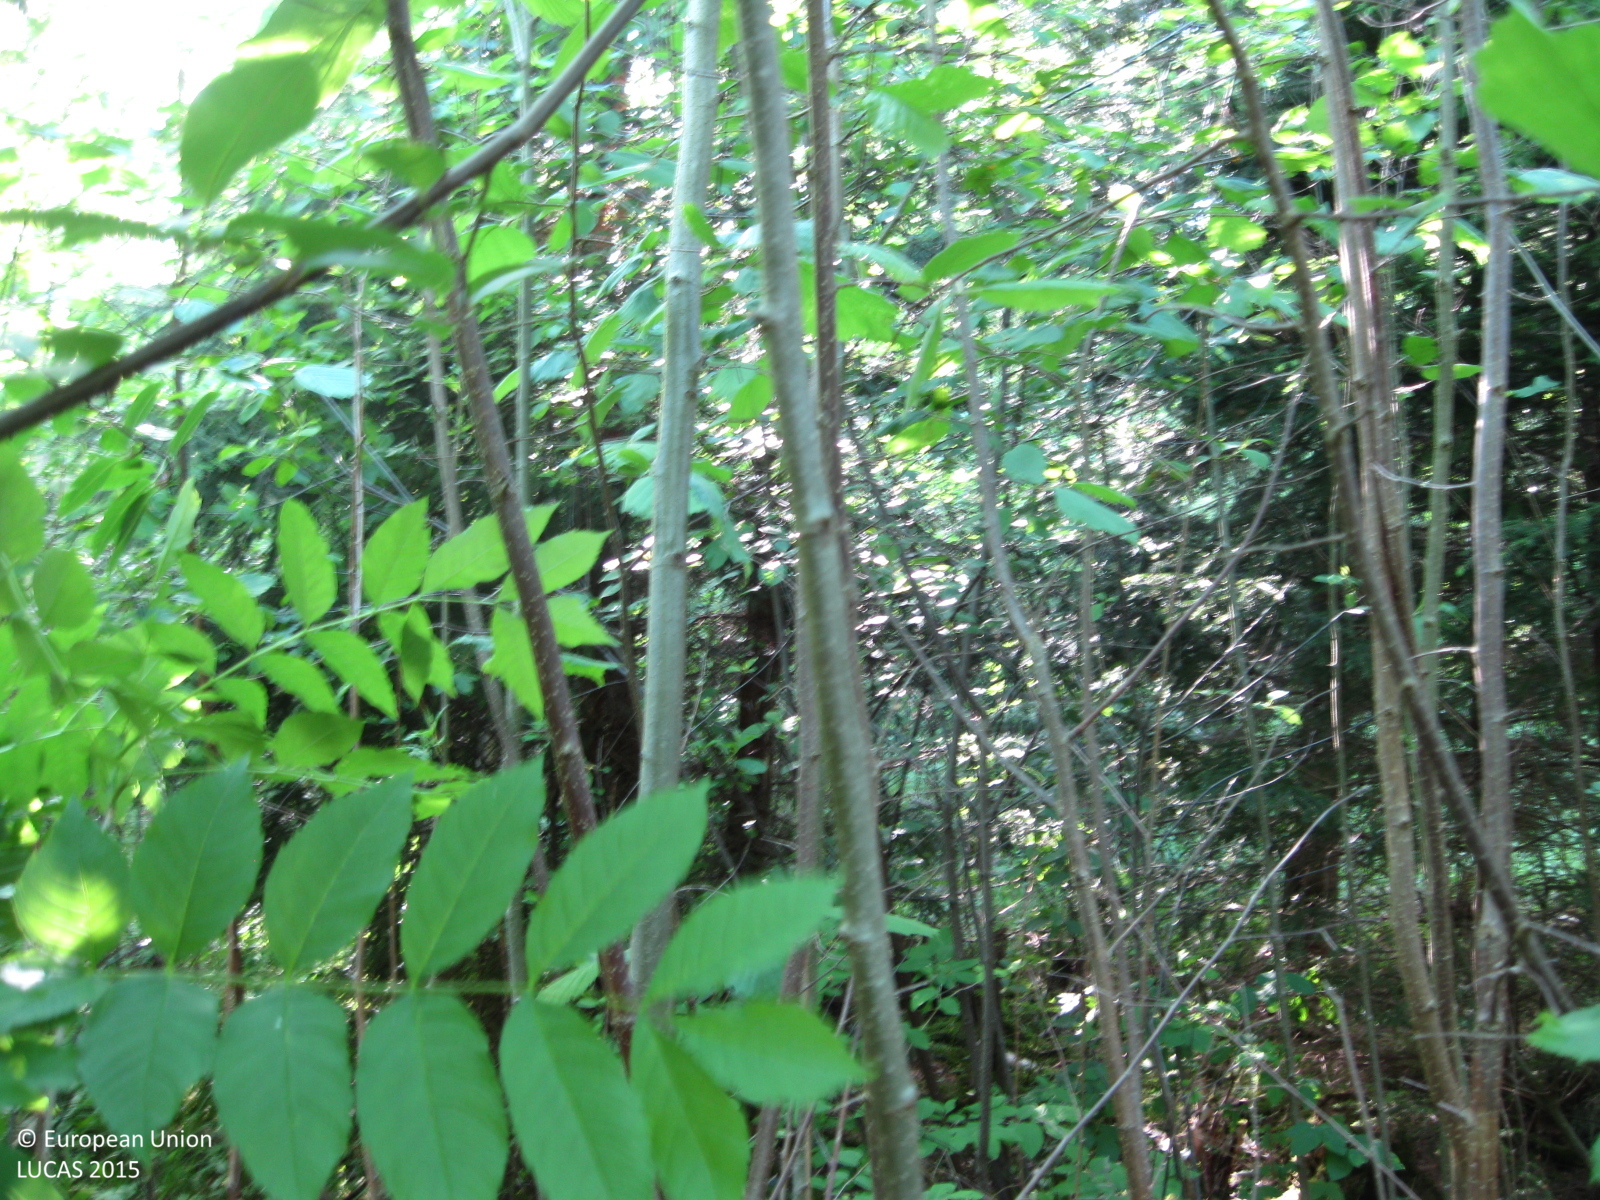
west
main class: Woodland
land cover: Spruce dominated mixed woodland
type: hemiboreal forest and nemoral coniferous forest and mixed broadleaved-coniferous forest
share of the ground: > 75 %
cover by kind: broadleaved forest trees 60 %, coniferous forest trees 30 %, herbaceous plants 10 %
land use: Forestry
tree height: > 5 m
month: June
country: LT
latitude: 55.5678
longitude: 23.6078
